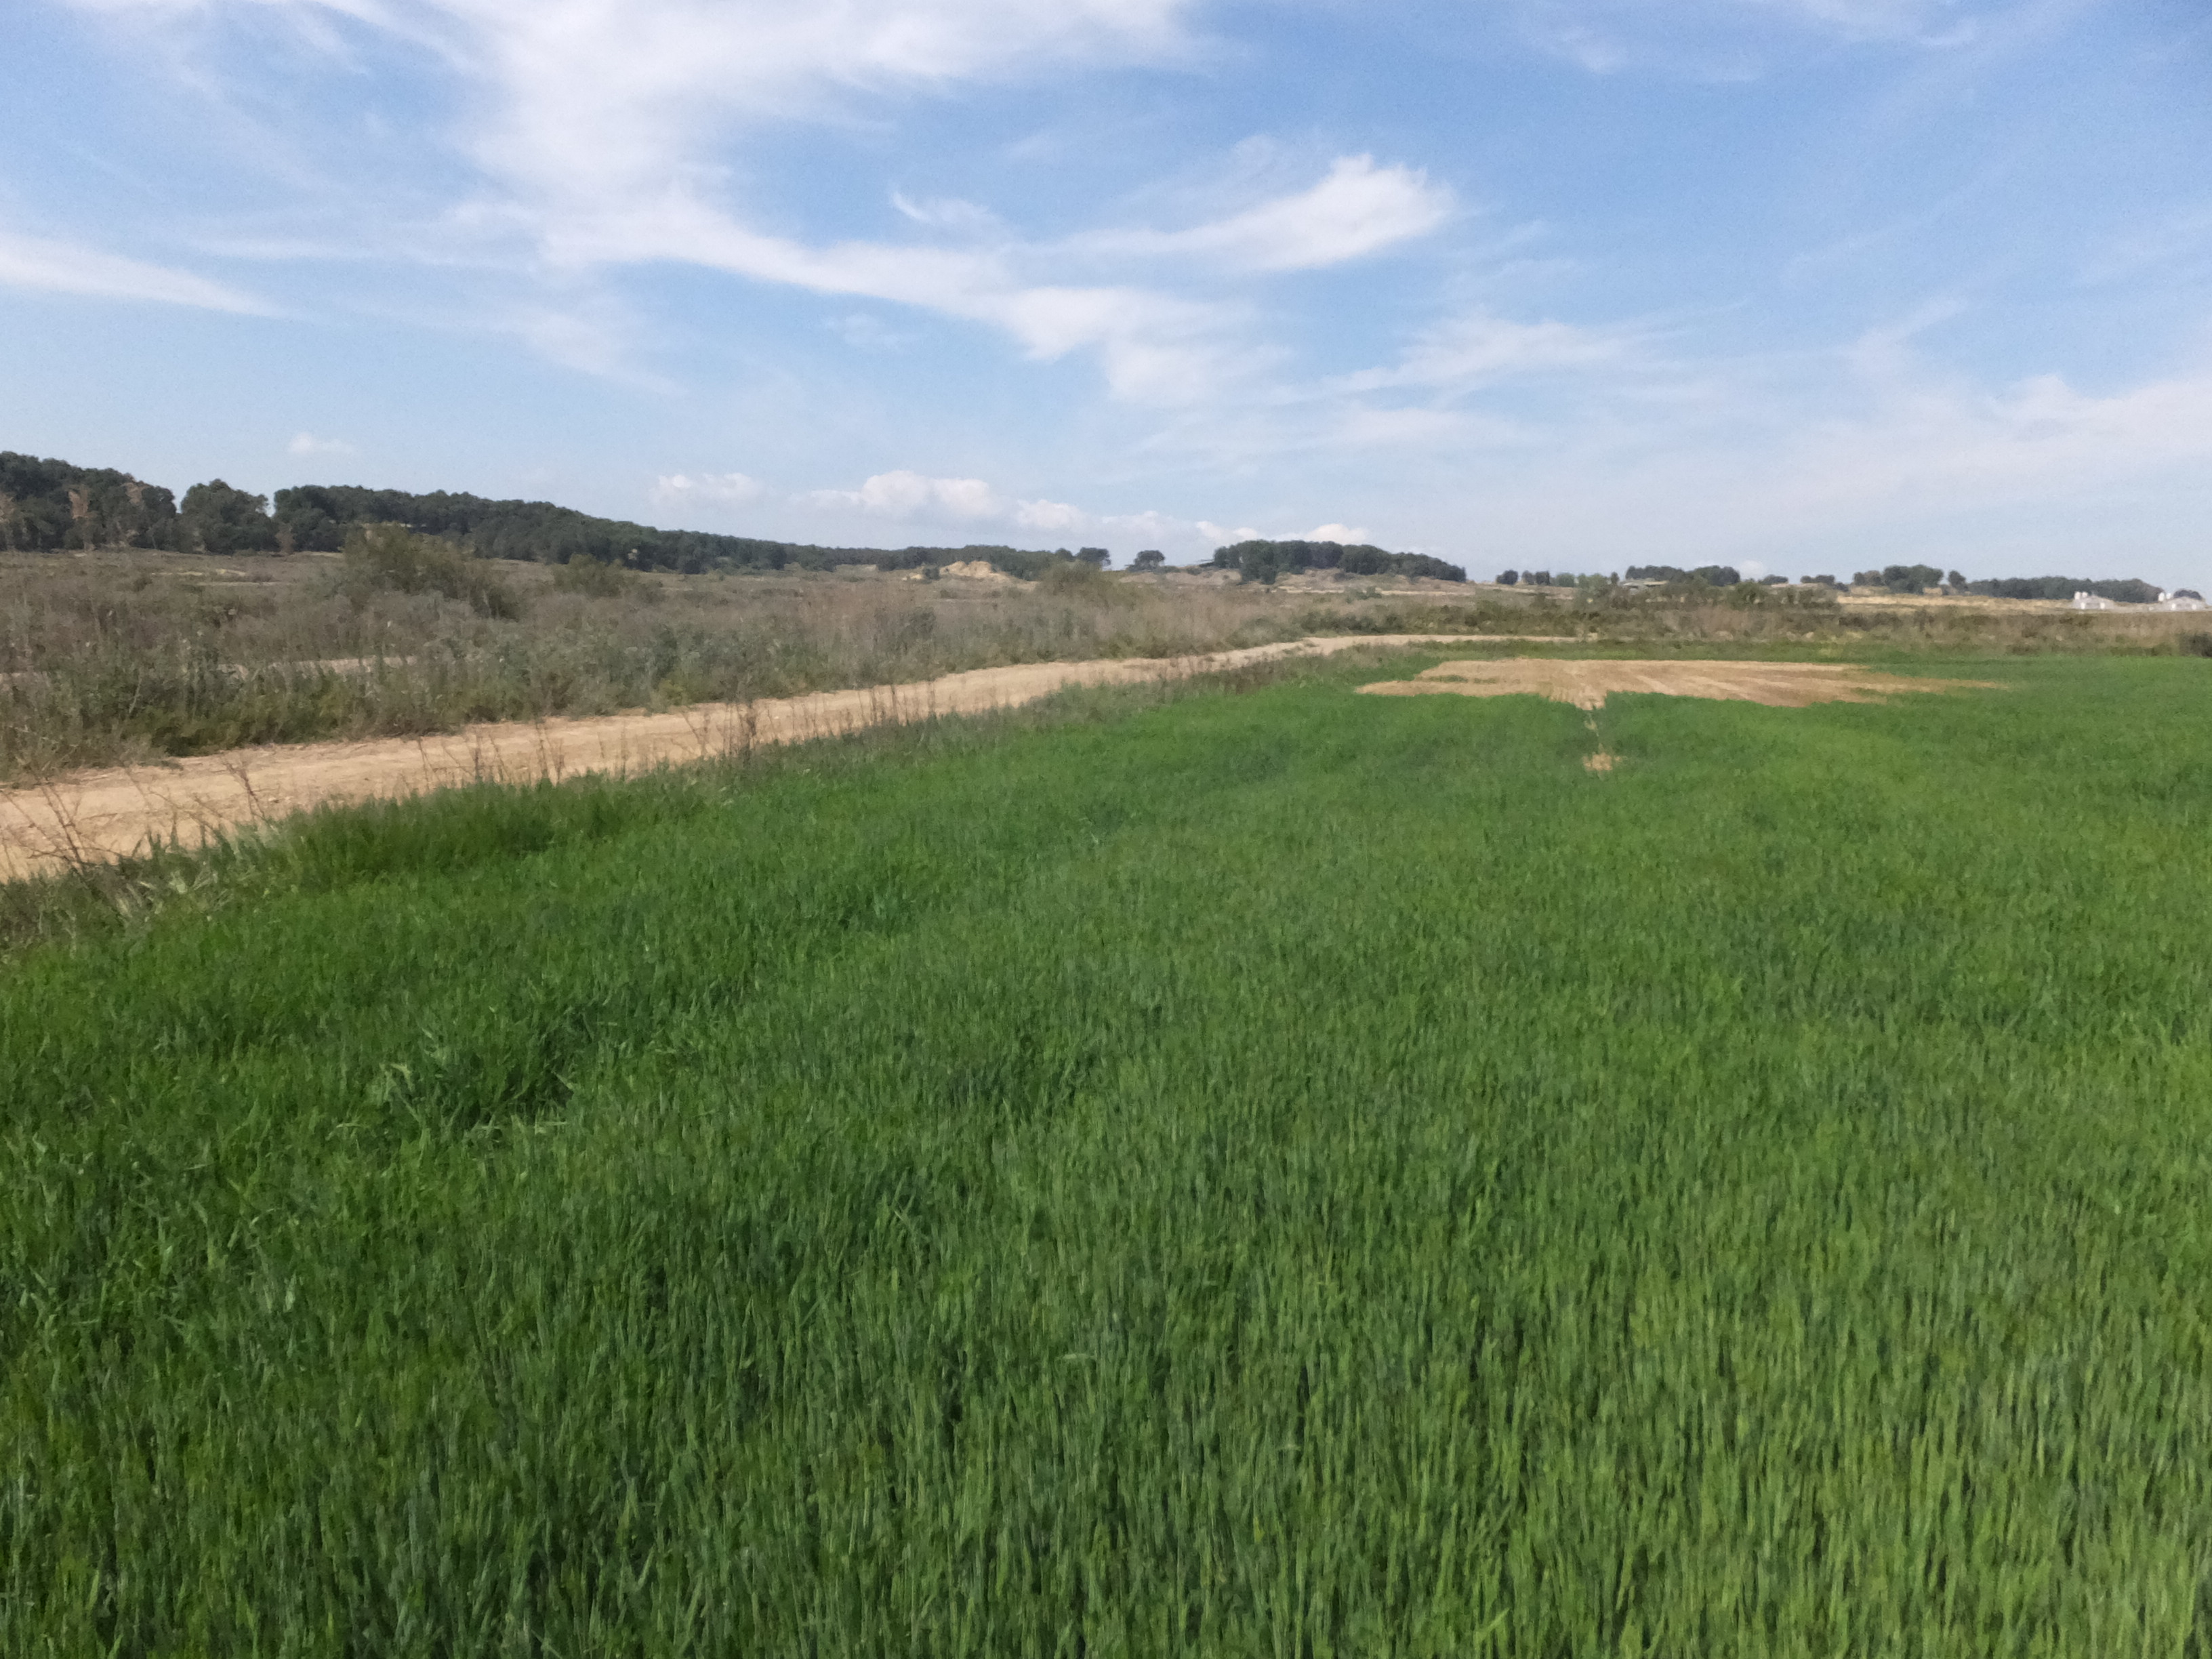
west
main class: Cropland
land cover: Durum wheat
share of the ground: > 75 %
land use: Agriculture (excluding fallow land and kitchen gardens)
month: April
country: ES
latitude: 41.7732
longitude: -0.2077
